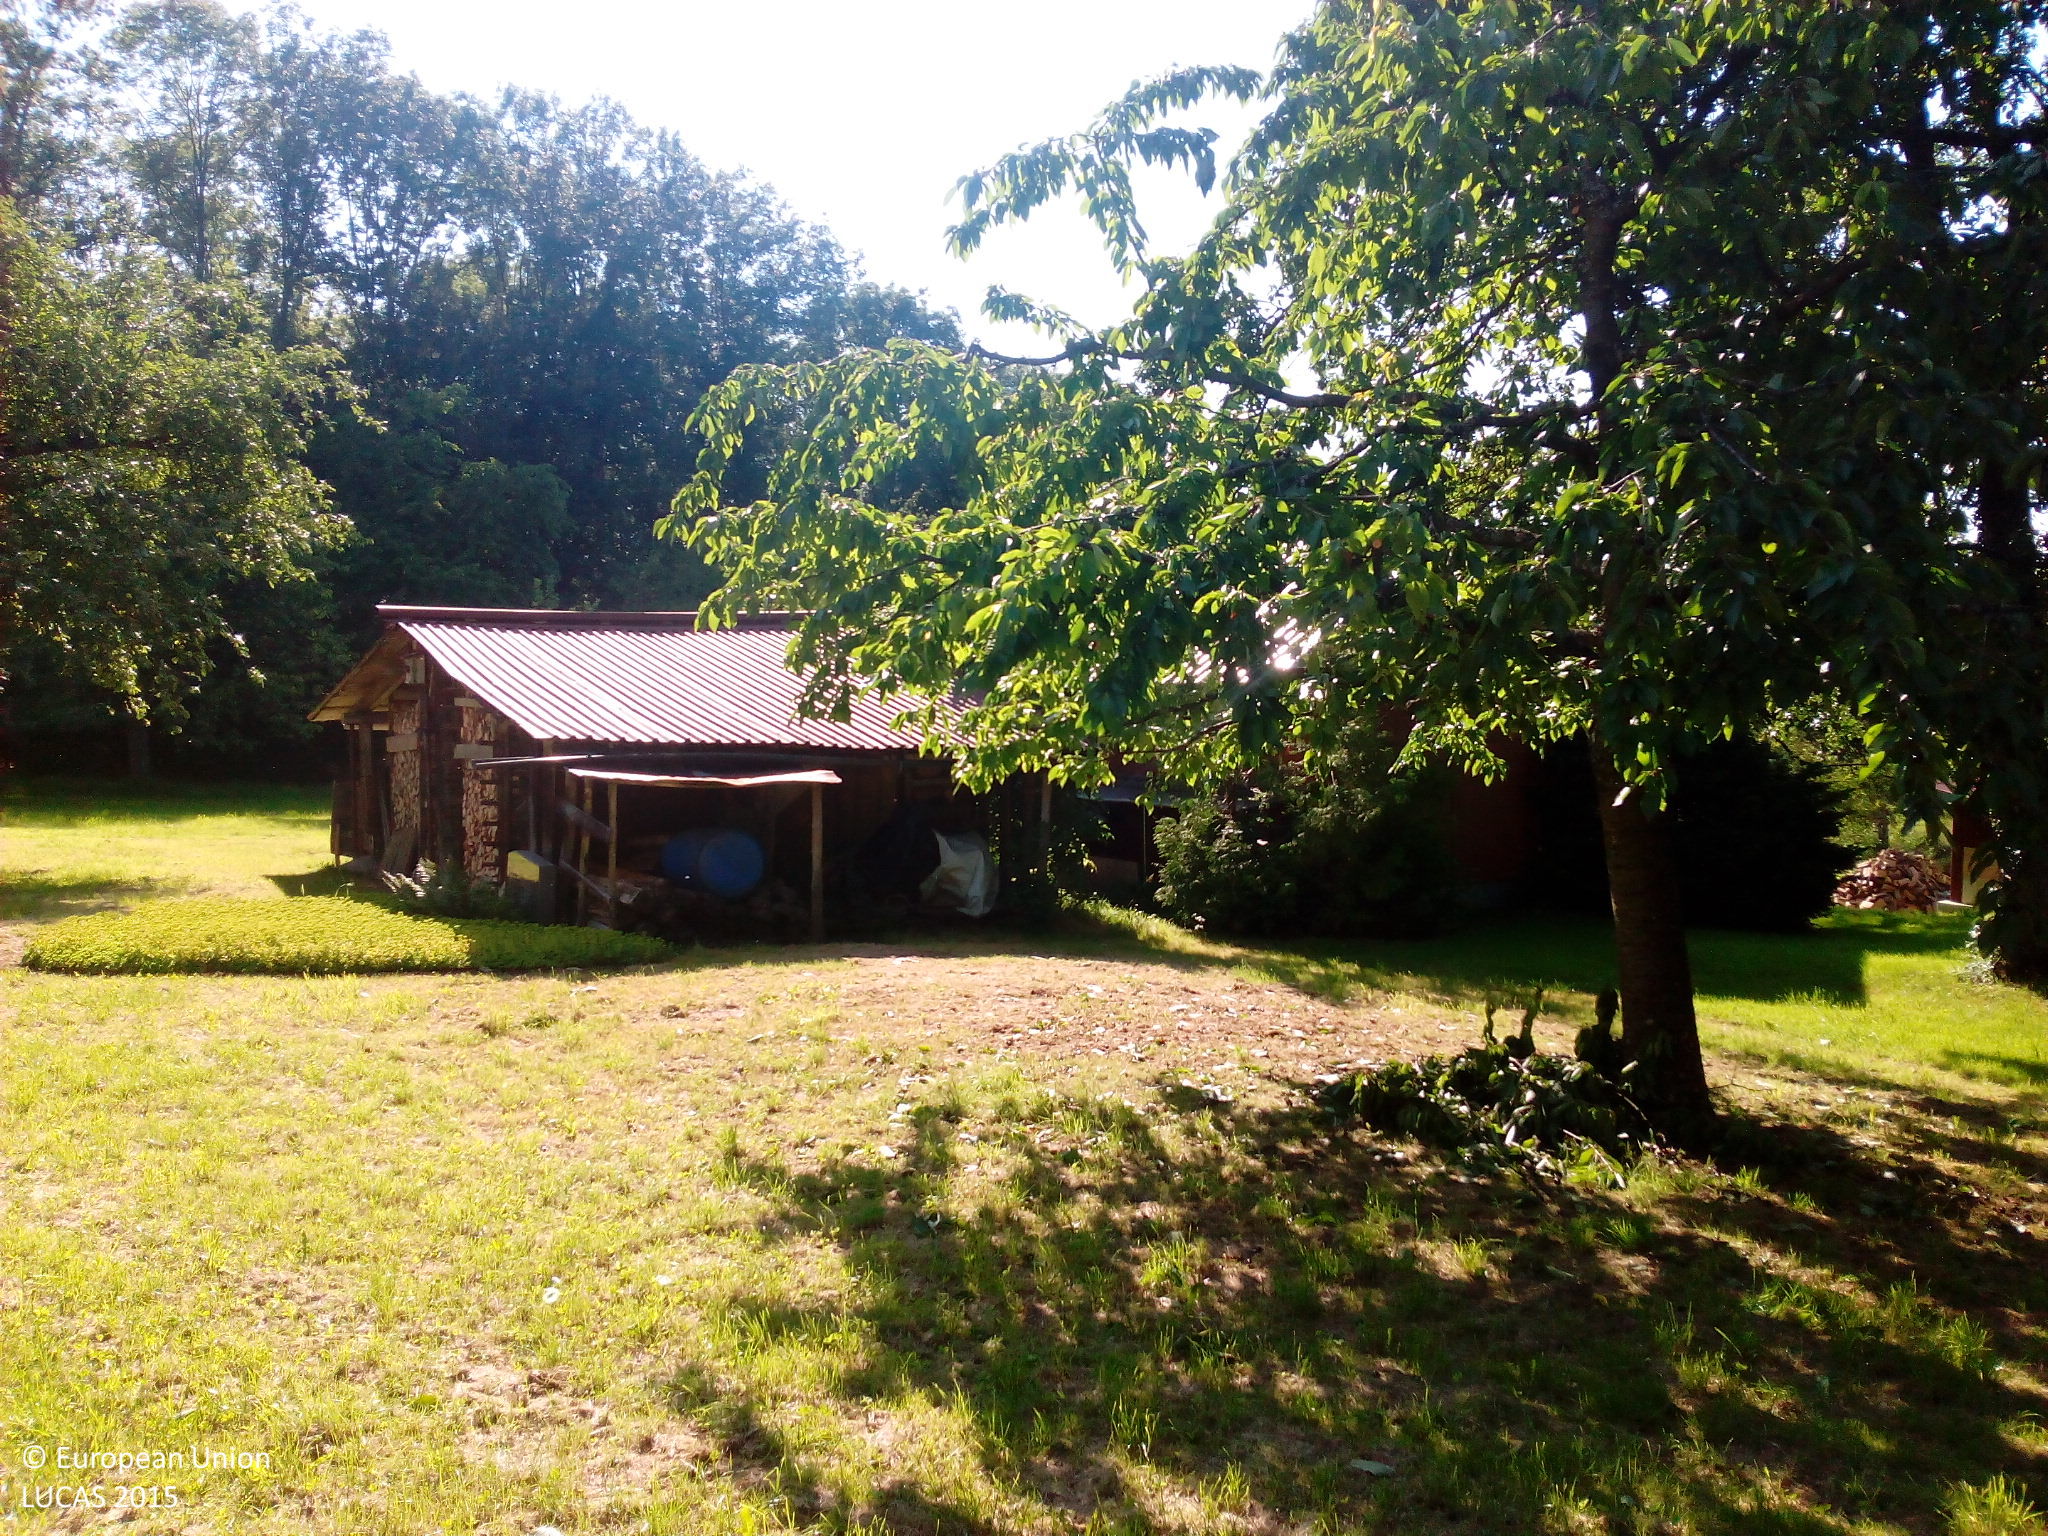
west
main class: Cropland
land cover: Apple fruit
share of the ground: 25 - 50 %
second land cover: Grassland without tree/shrub cover
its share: 50 - 75 %
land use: Agriculture (excluding fallow land and kitchen gardens)
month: June
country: DE
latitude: 48.5637
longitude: 9.3905
